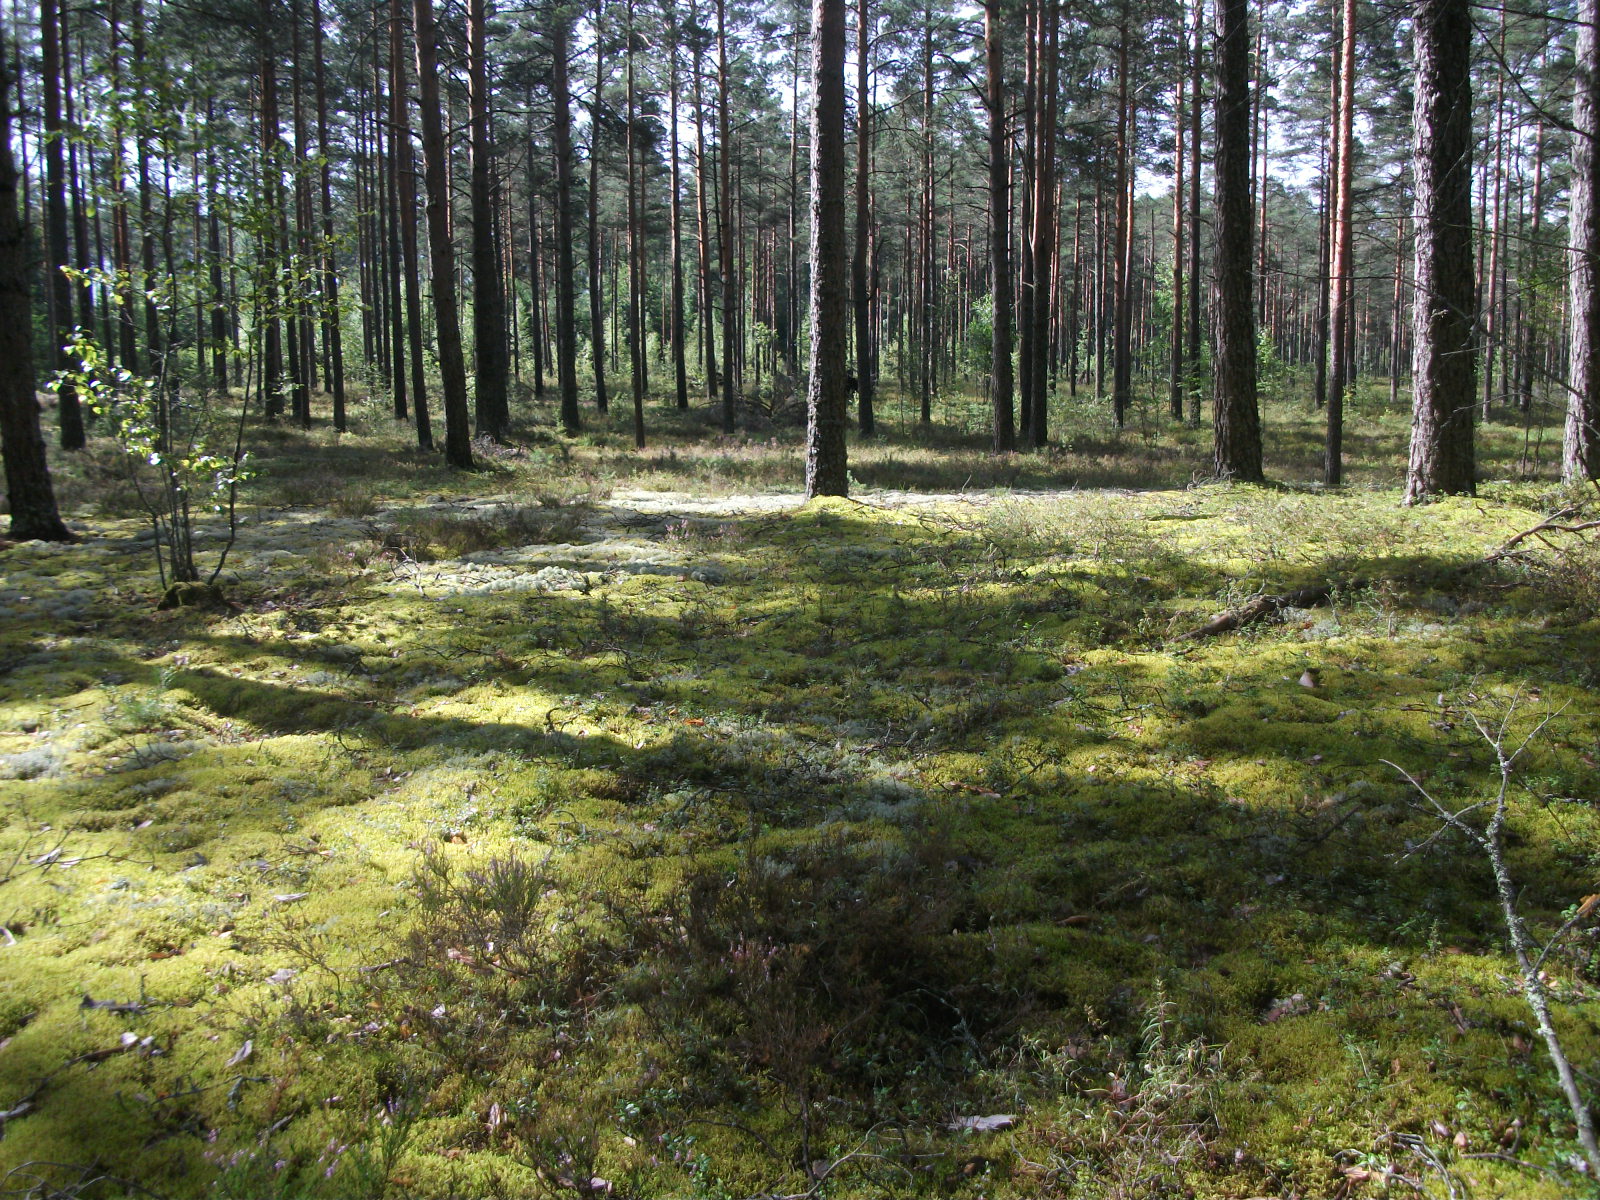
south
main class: Woodland
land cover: Pine dominated coniferous woodland
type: hemiboreal forest and nemoral coniferous forest and mixed broadleaved-coniferous forest
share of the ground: 50 - 75 %
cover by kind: coniferous forest trees 65 %, lichens and mosses 35 %
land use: Forestry
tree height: > 5 m
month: August
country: LV
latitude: 56.5058
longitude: 26.5097
